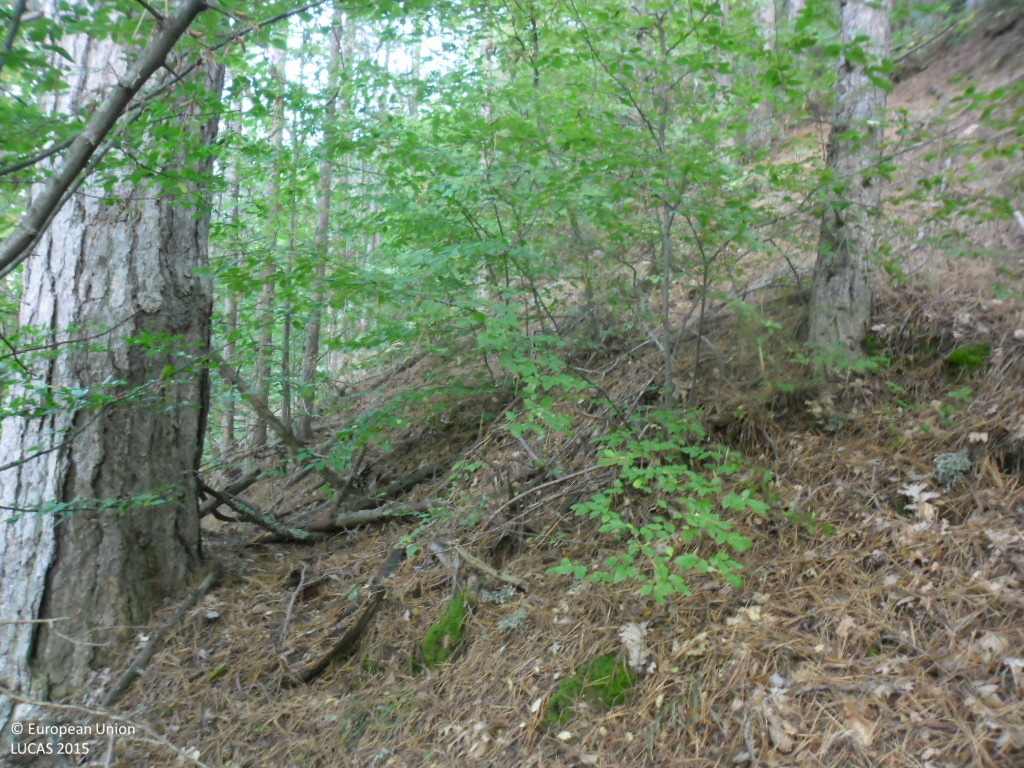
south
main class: Woodland
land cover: Pine dominated mixed woodland
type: hemiboreal forest and nemoral coniferous forest and mixed broadleaved-coniferous forest
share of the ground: > 75 %
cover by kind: coniferous forest trees 65 %, broadleaved forest trees 35 %
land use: Forestry
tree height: > 5 m
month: September
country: BG
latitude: 41.8946
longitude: 22.9295
